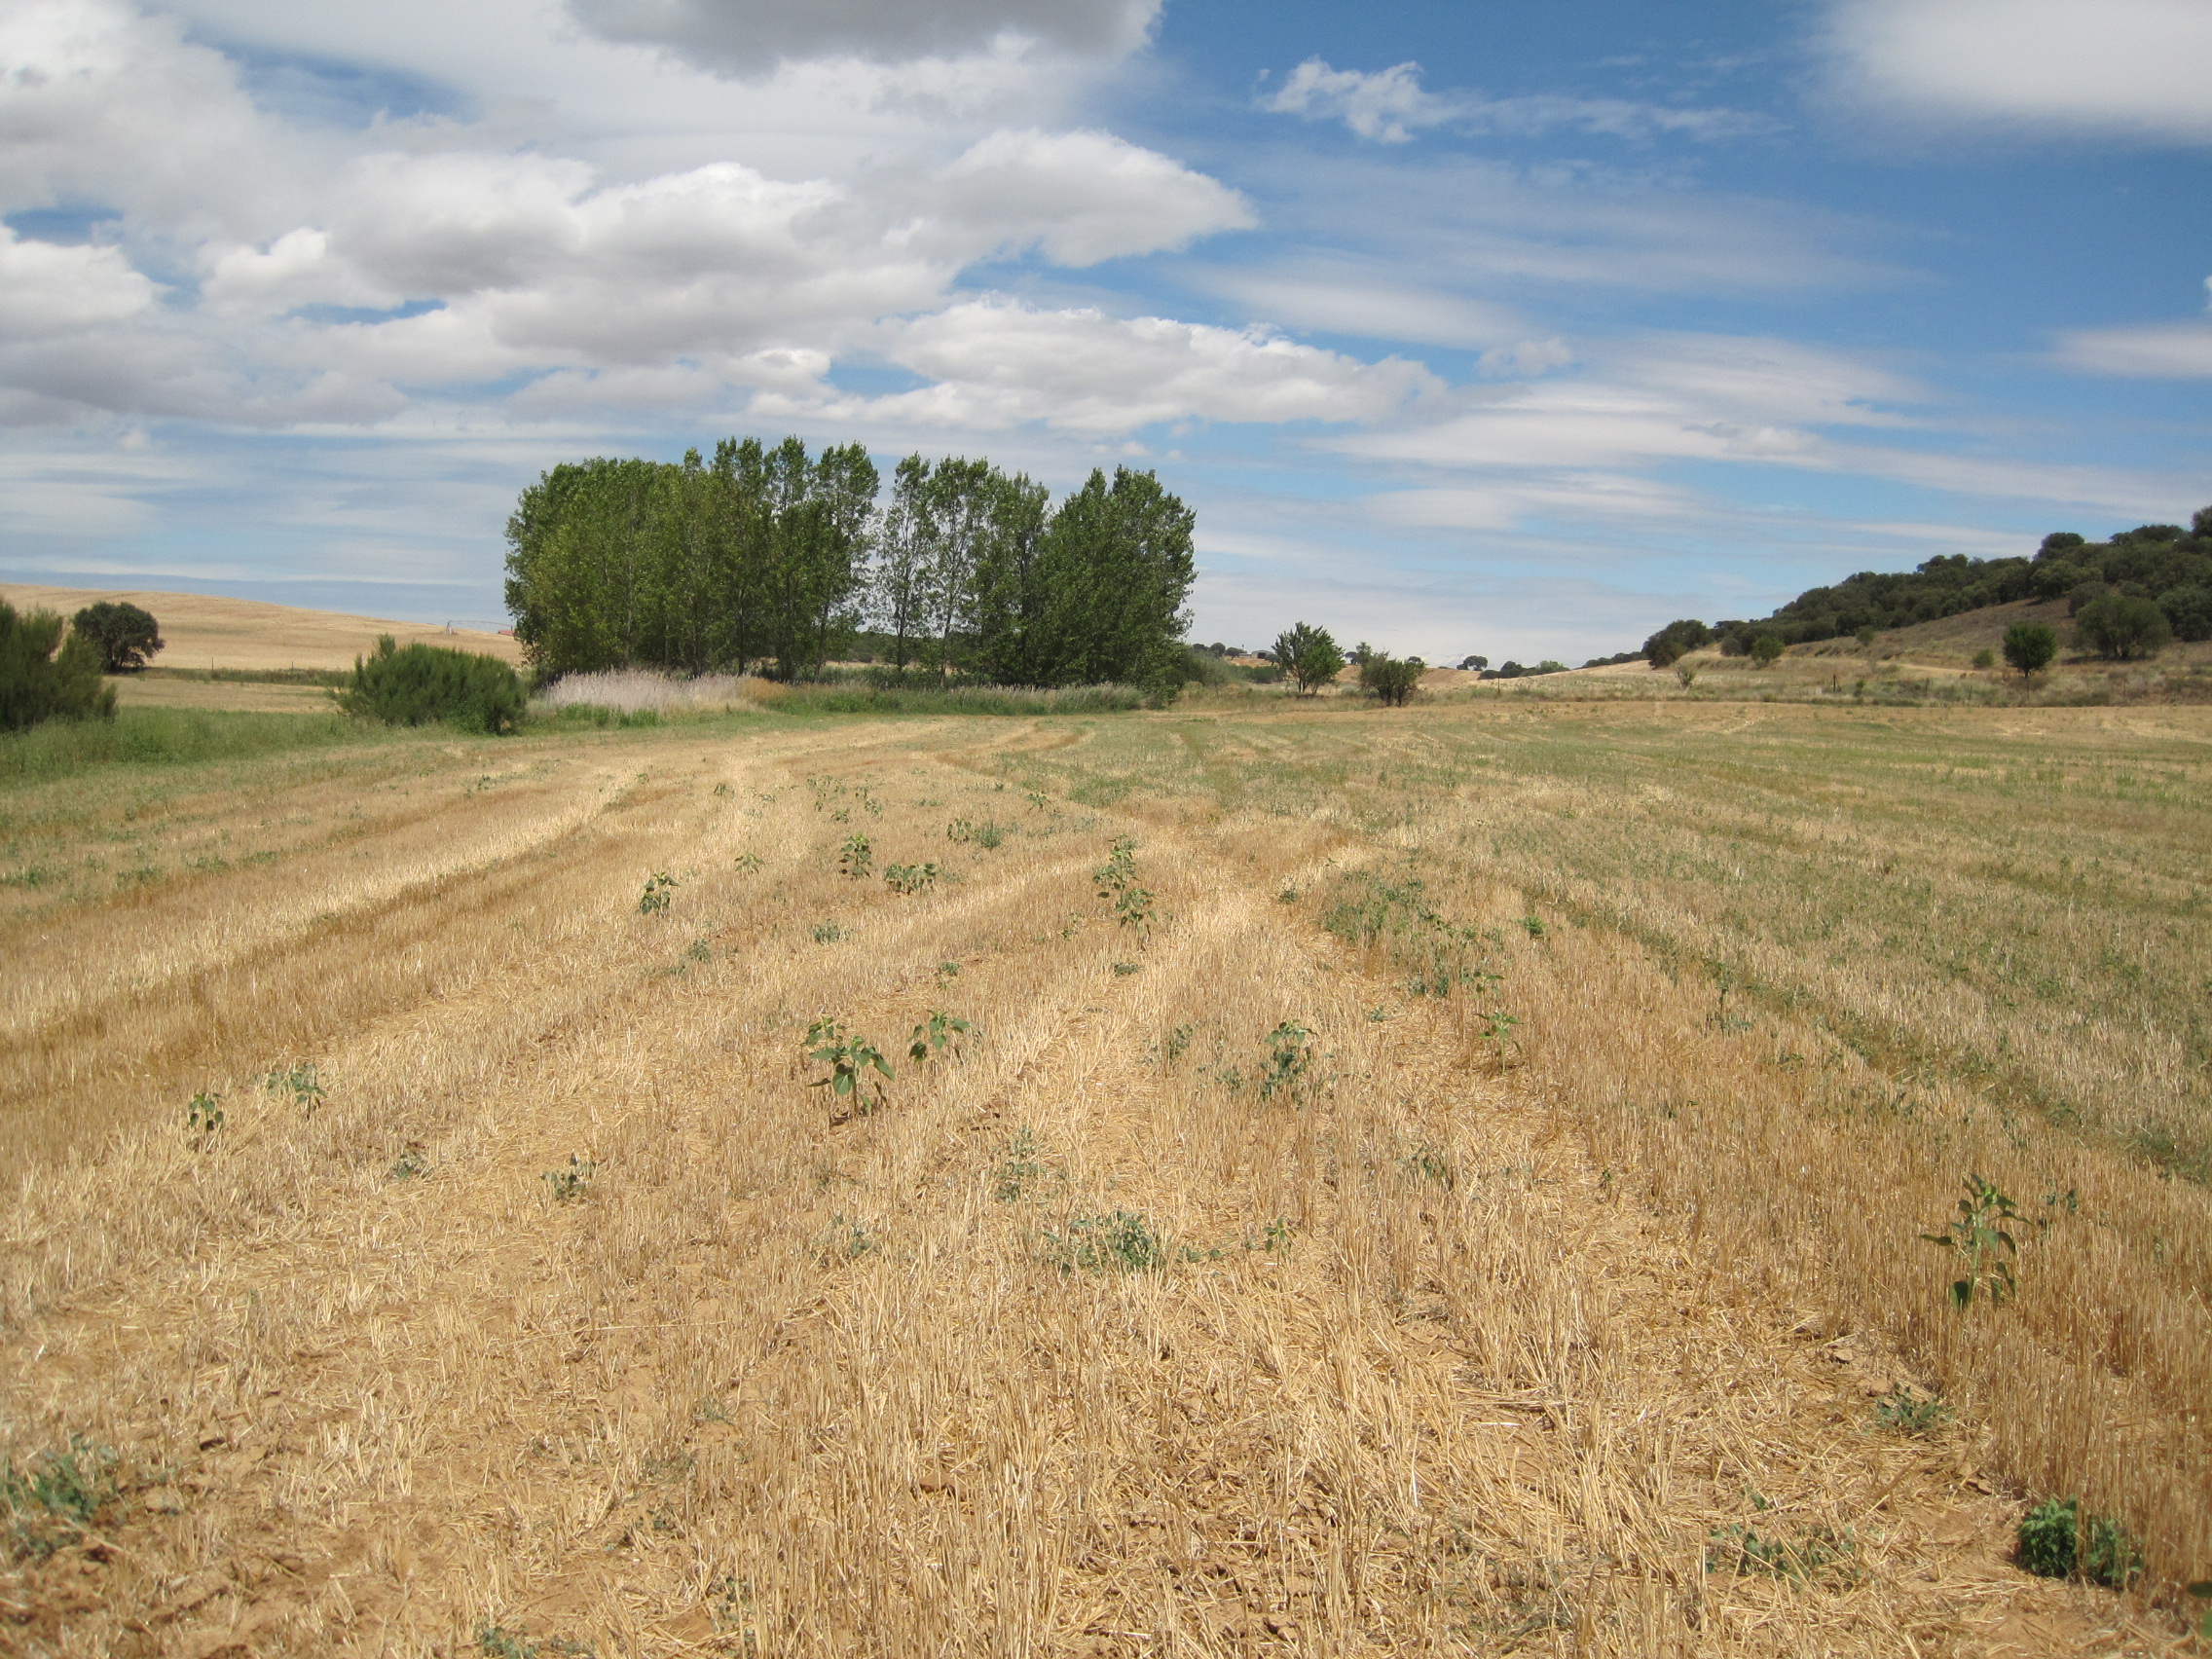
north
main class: Cropland
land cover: Barley
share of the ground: < 10 %
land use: Agriculture (excluding fallow land and kitchen gardens)
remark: Harvested field
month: July
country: ES
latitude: 42.0264
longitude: -5.5860
